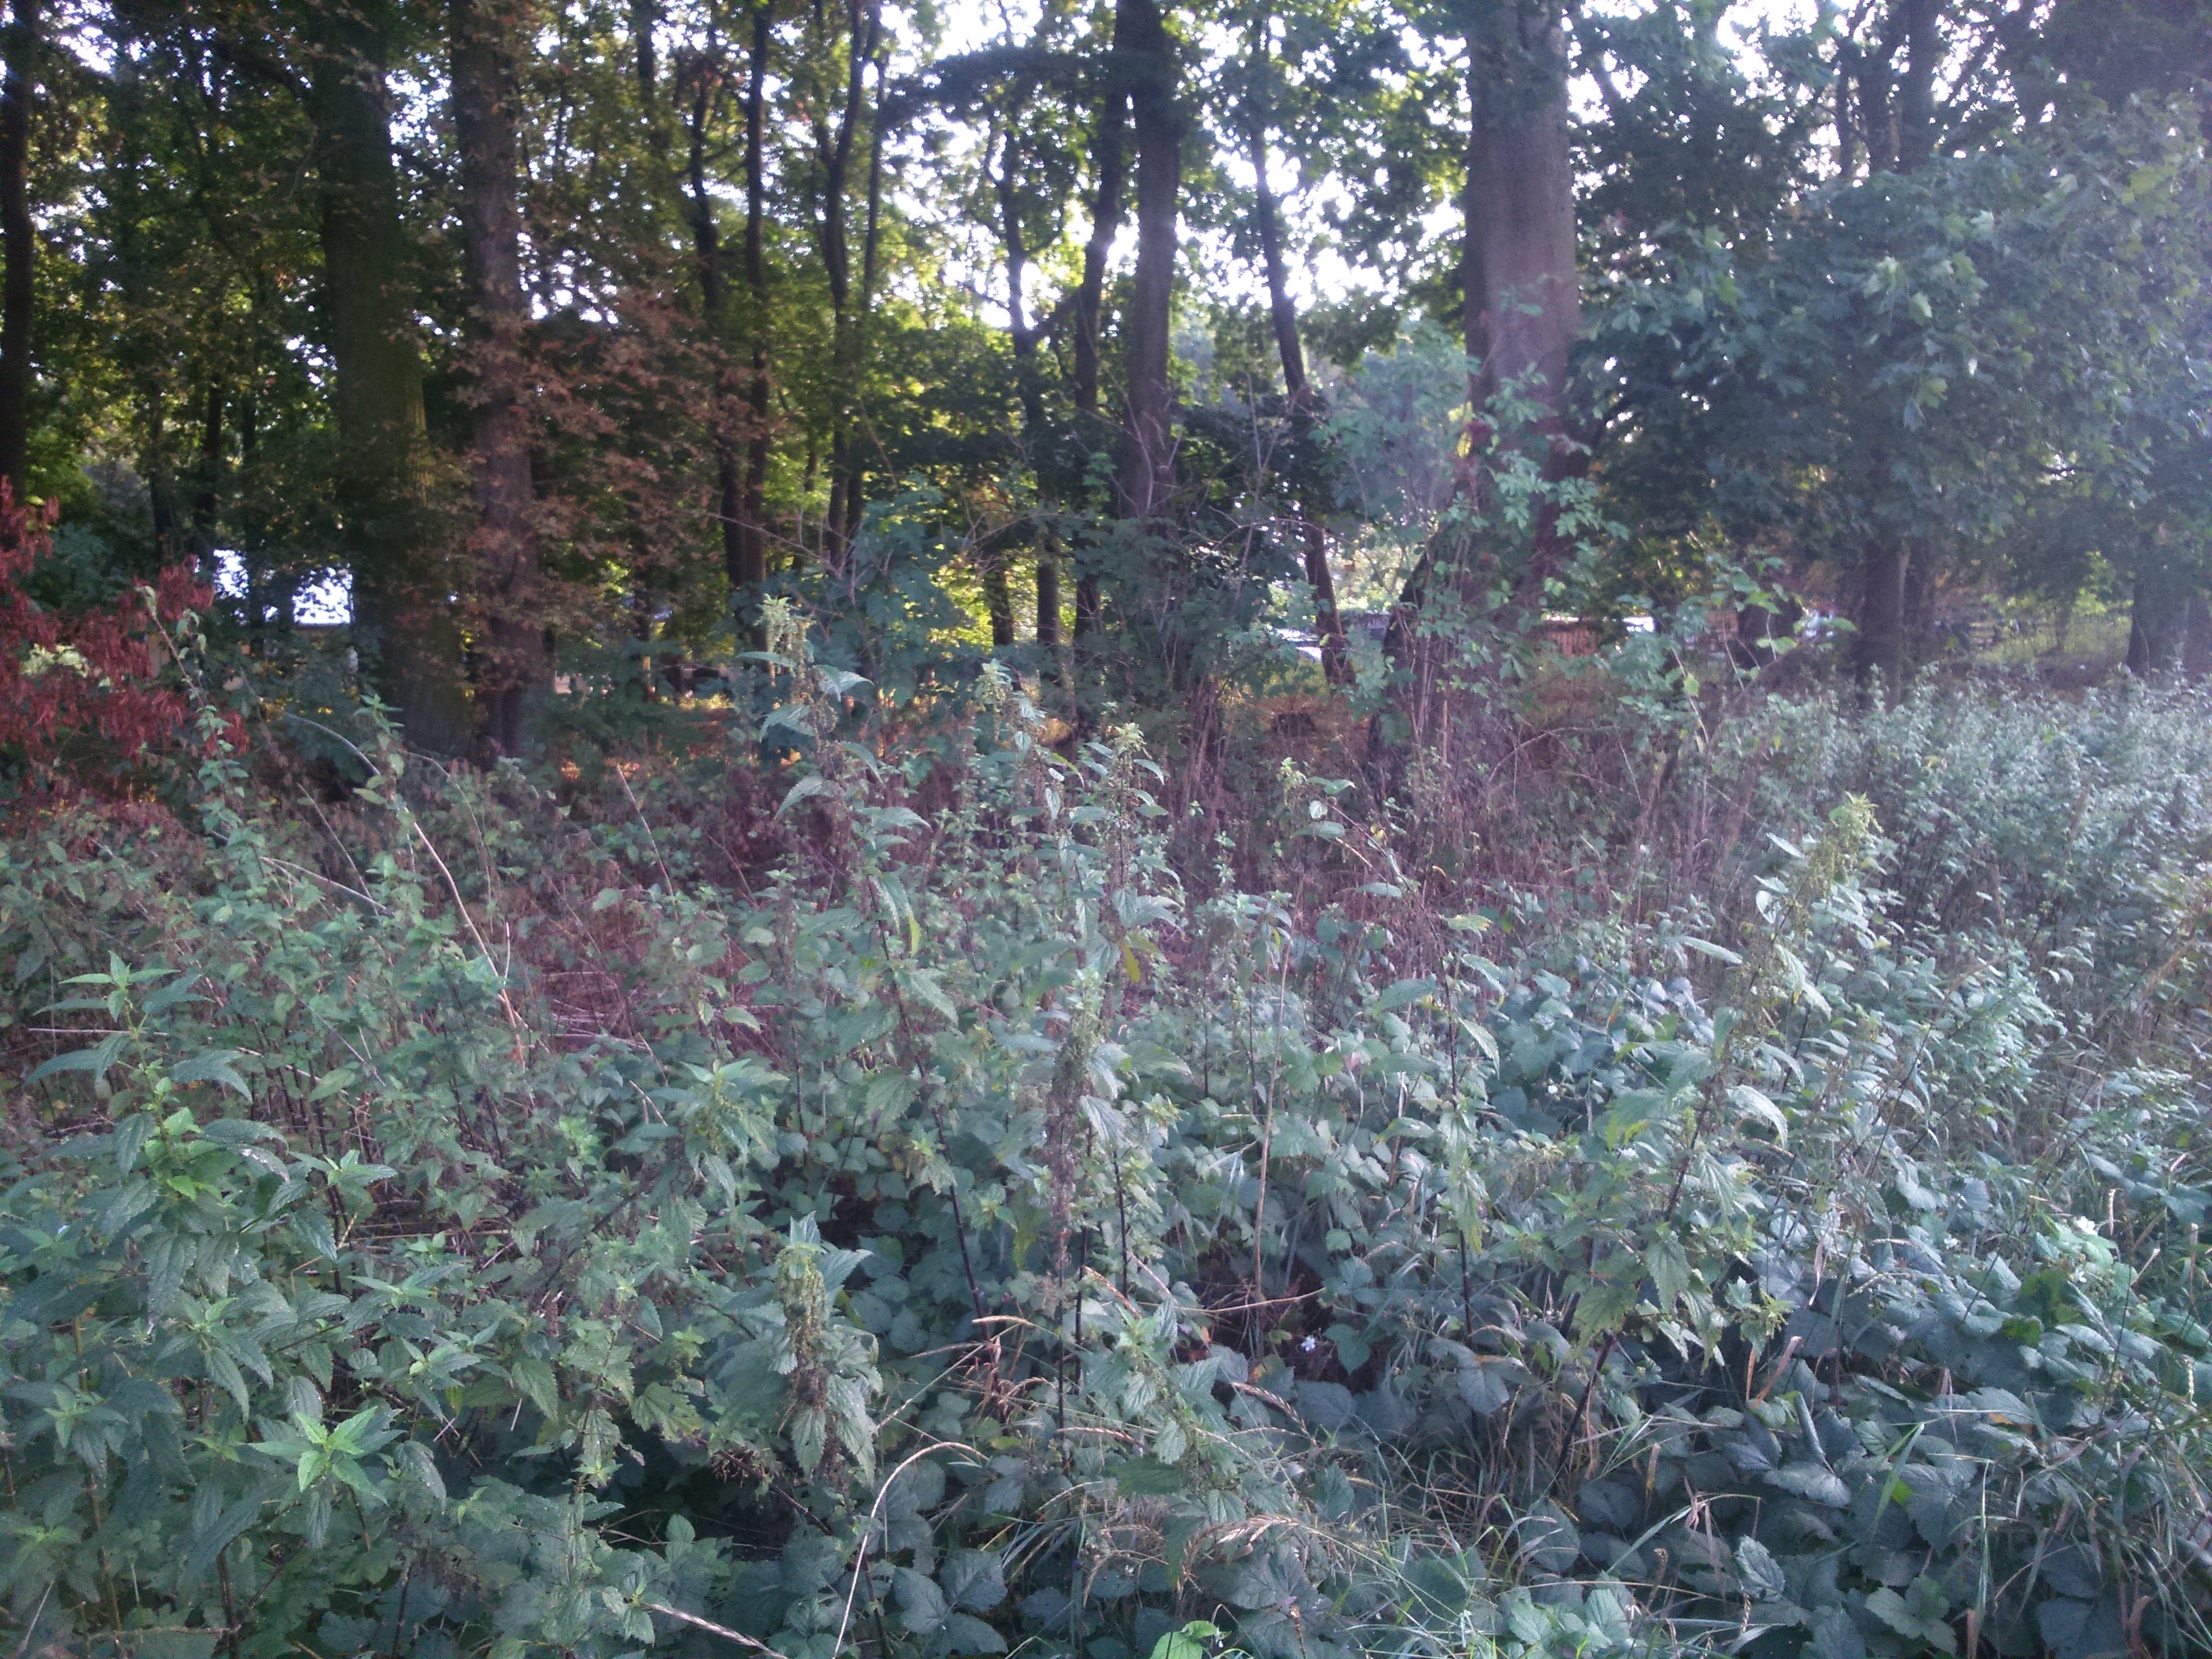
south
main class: Cropland
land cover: Maize
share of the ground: > 75 %
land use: Agriculture (excluding fallow land and kitchen gardens)
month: September
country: PL
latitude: 52.4162
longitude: 22.2210
